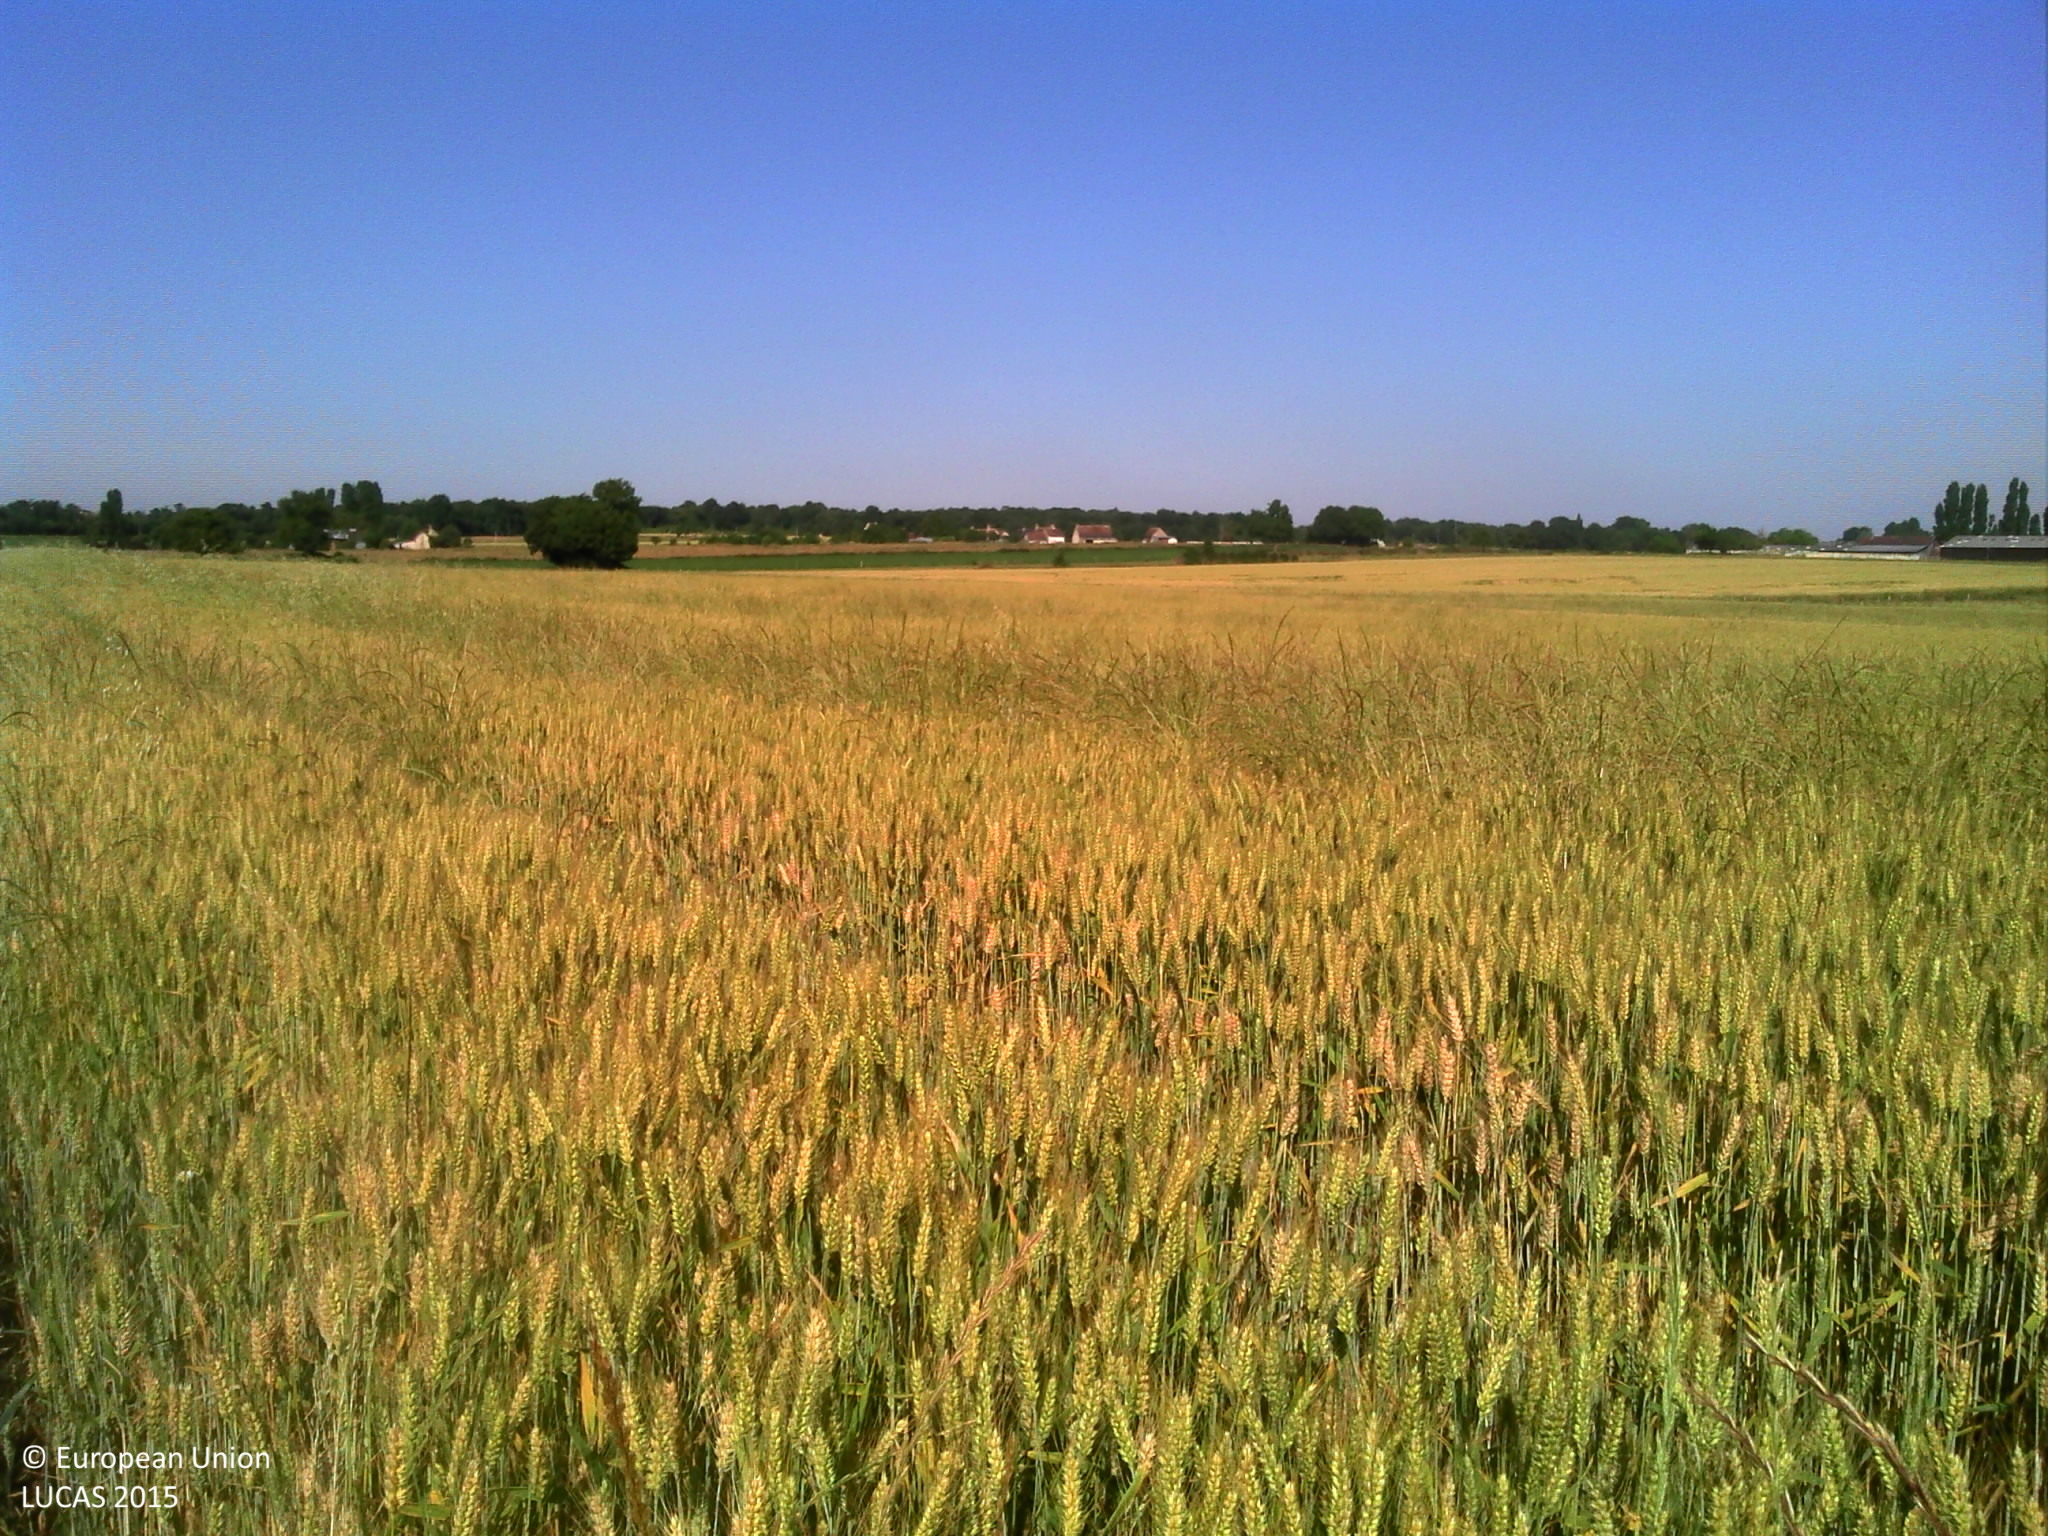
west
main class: Cropland
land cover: Durum wheat
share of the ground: > 75 %
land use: Agriculture (excluding fallow land and kitchen gardens)
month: June
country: FR
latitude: 47.5032
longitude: 0.4861
